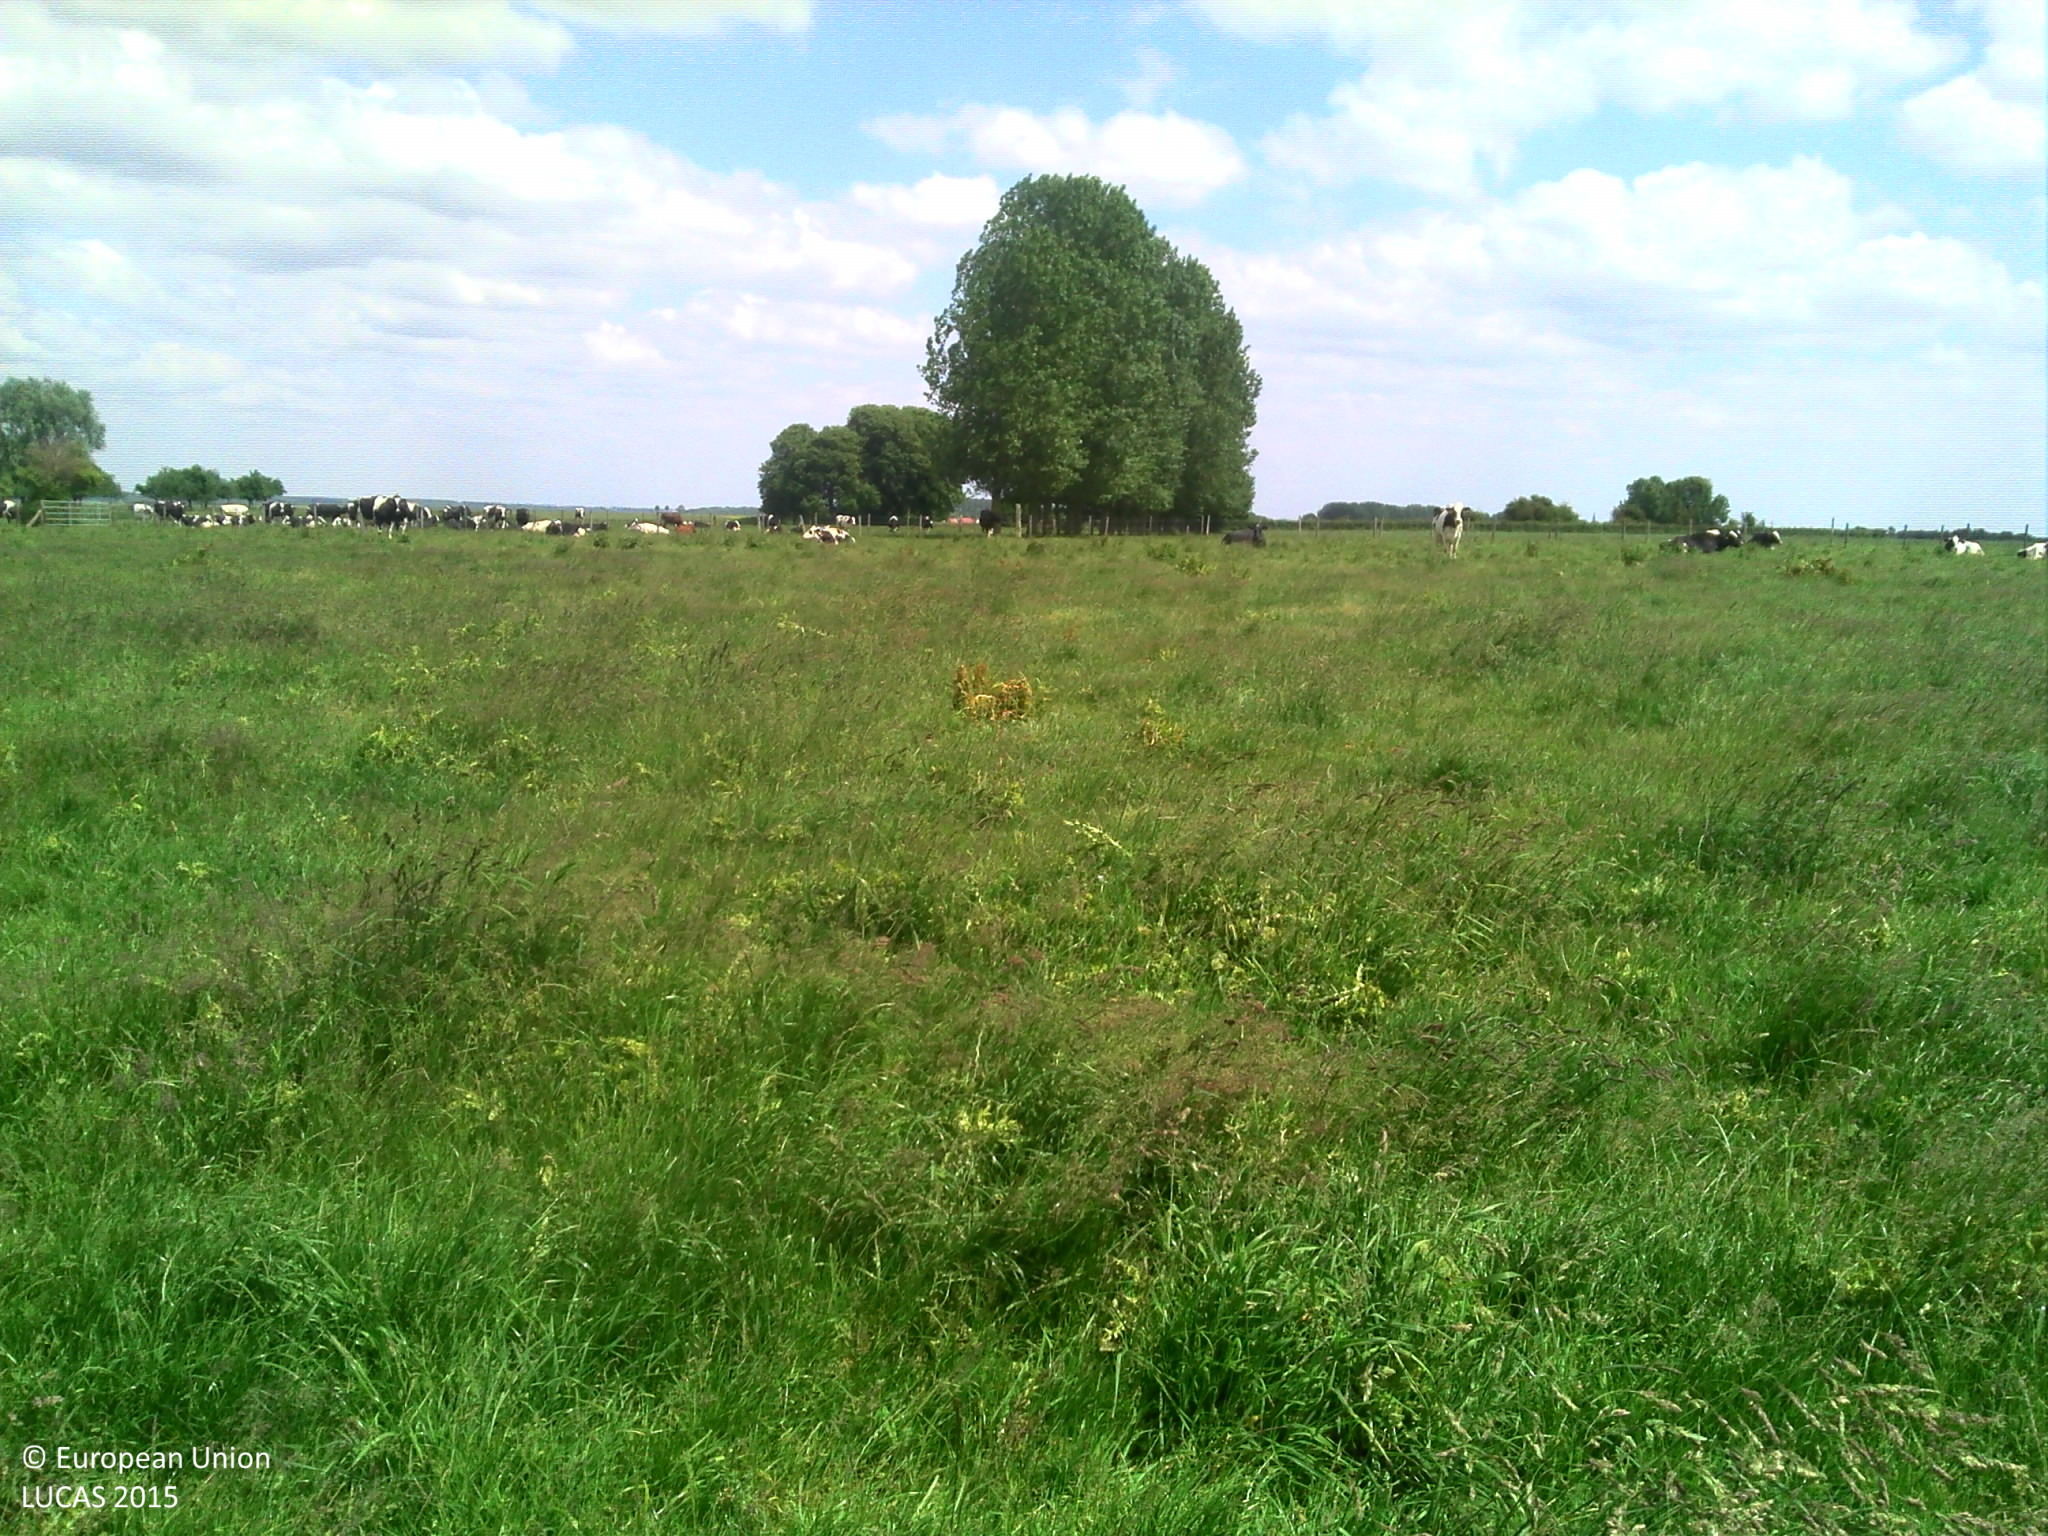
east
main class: Cropland
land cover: Barley
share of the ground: > 75 %
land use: Agriculture (excluding fallow land and kitchen gardens)
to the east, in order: Grass margins; Fences; Grassland without tree/shrub cover; Lines of trees; Grassland without tree/shrub cover; Fences; Grassland without tree/shrub cover
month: June
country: FR
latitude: 50.1135
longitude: 1.6616
